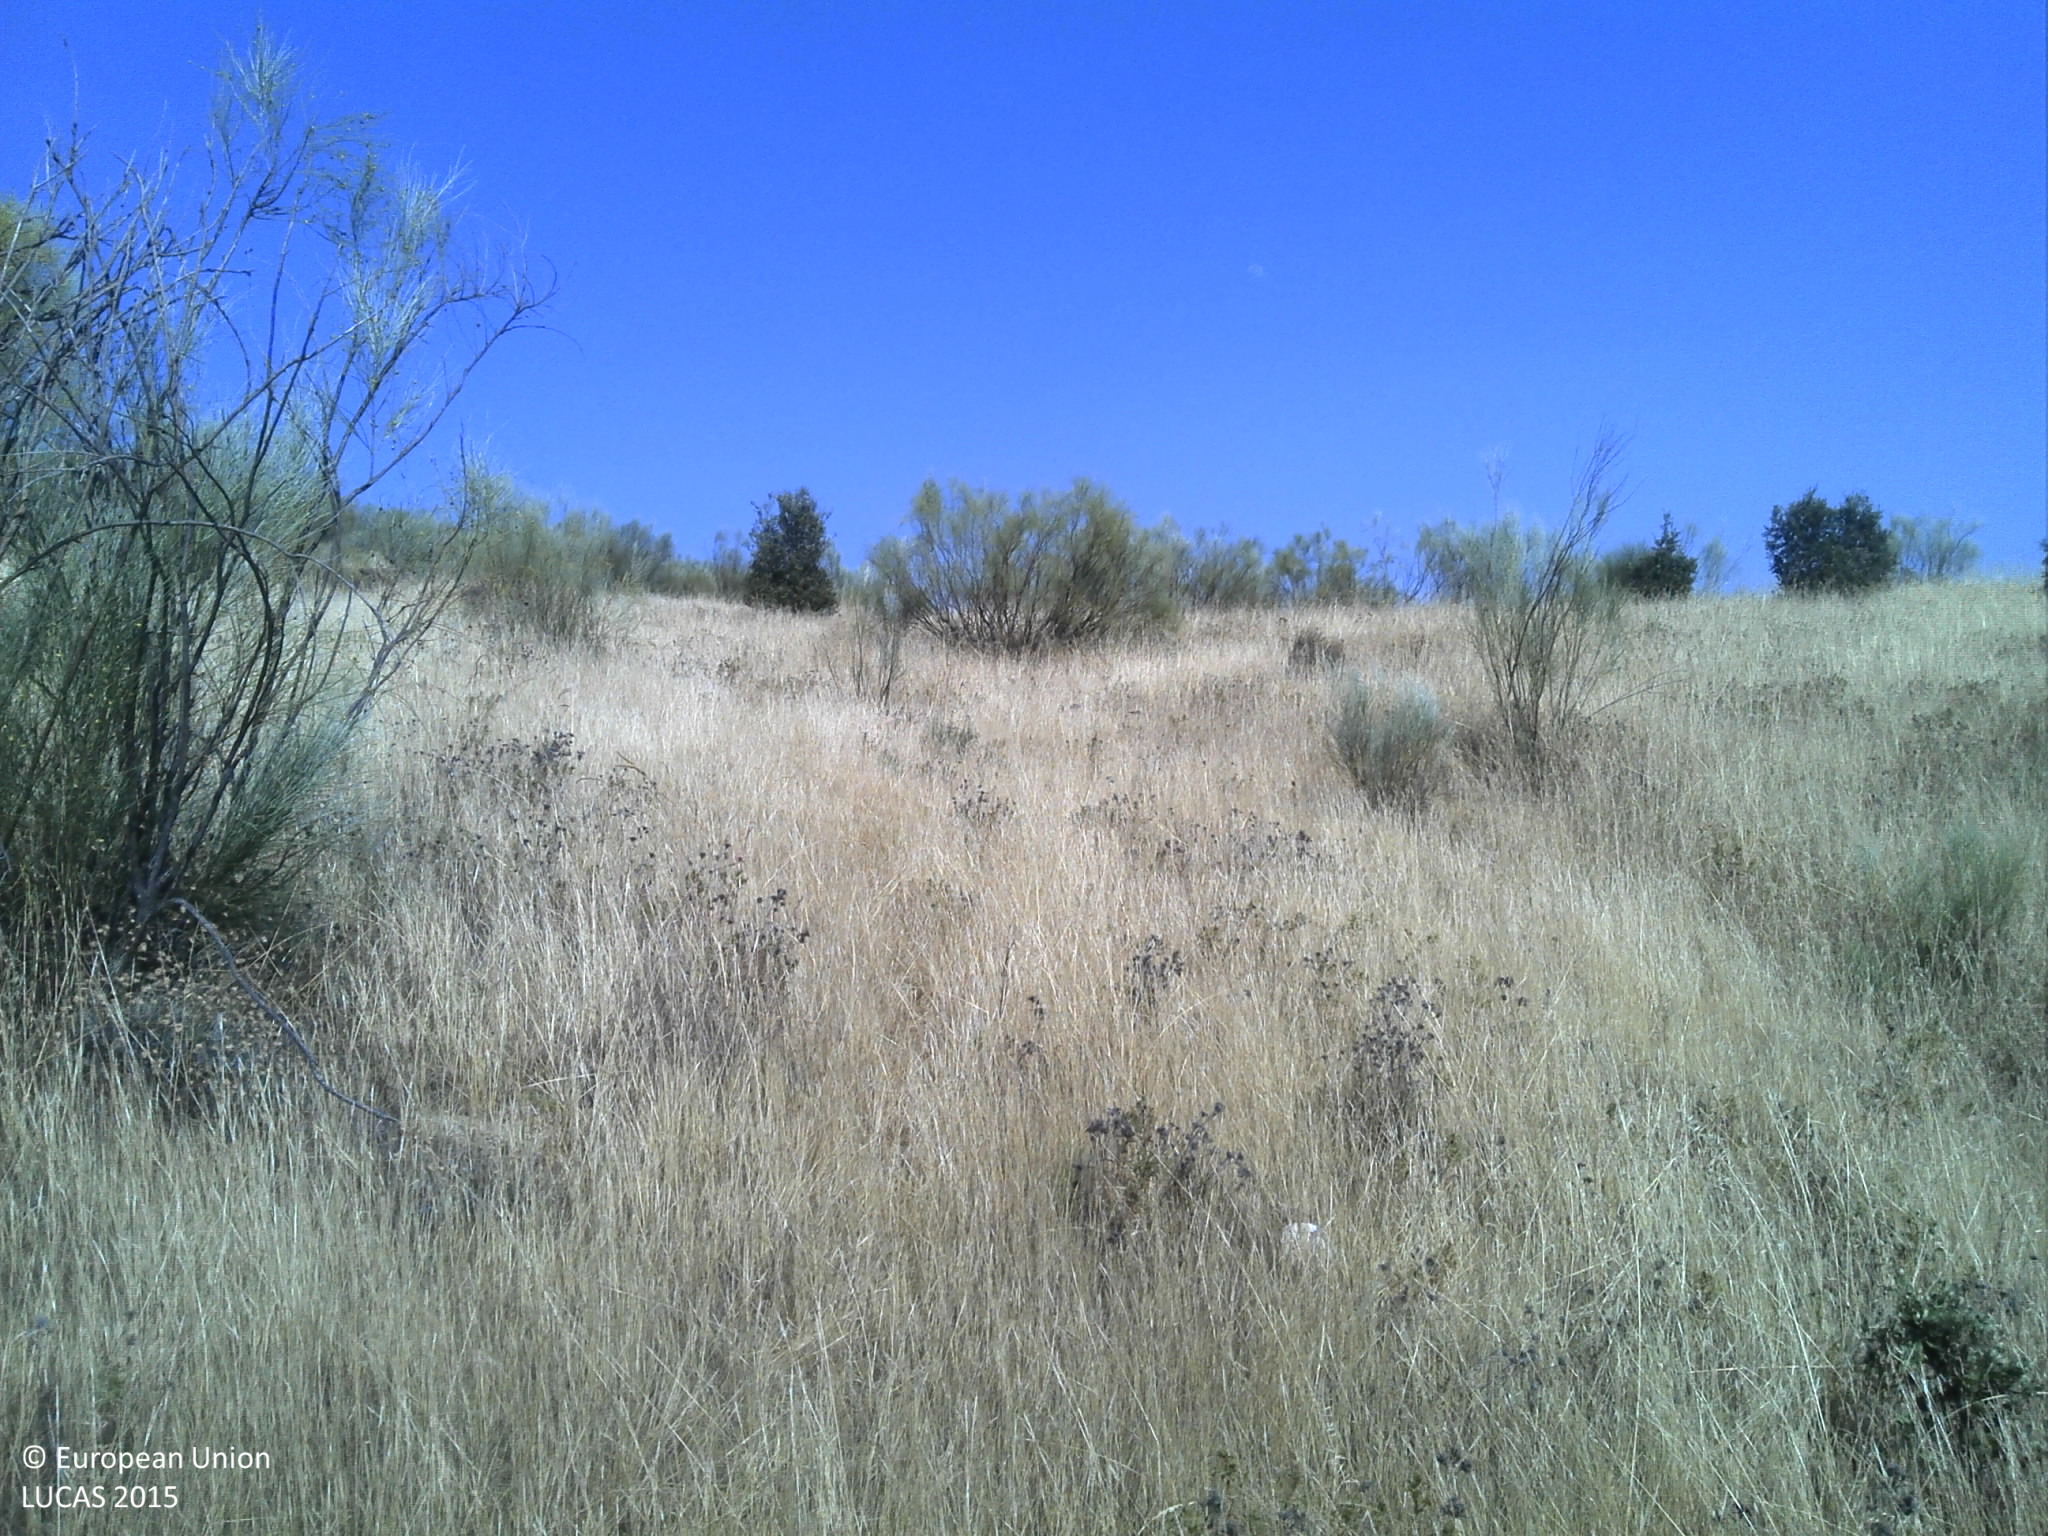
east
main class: Shrubland
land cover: Shrubland without tree cover
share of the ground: 50 - 75 %
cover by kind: shrubs 55 %, herbaceous plants 45 %
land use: Agriculture (excluding fallow land and kitchen gardens)
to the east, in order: Shrubland without tree cover; Tracks; Shrubland without tree cover; Tracks; Shrubland without tree cover
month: June
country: PT
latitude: 39.7385
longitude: -7.1612
